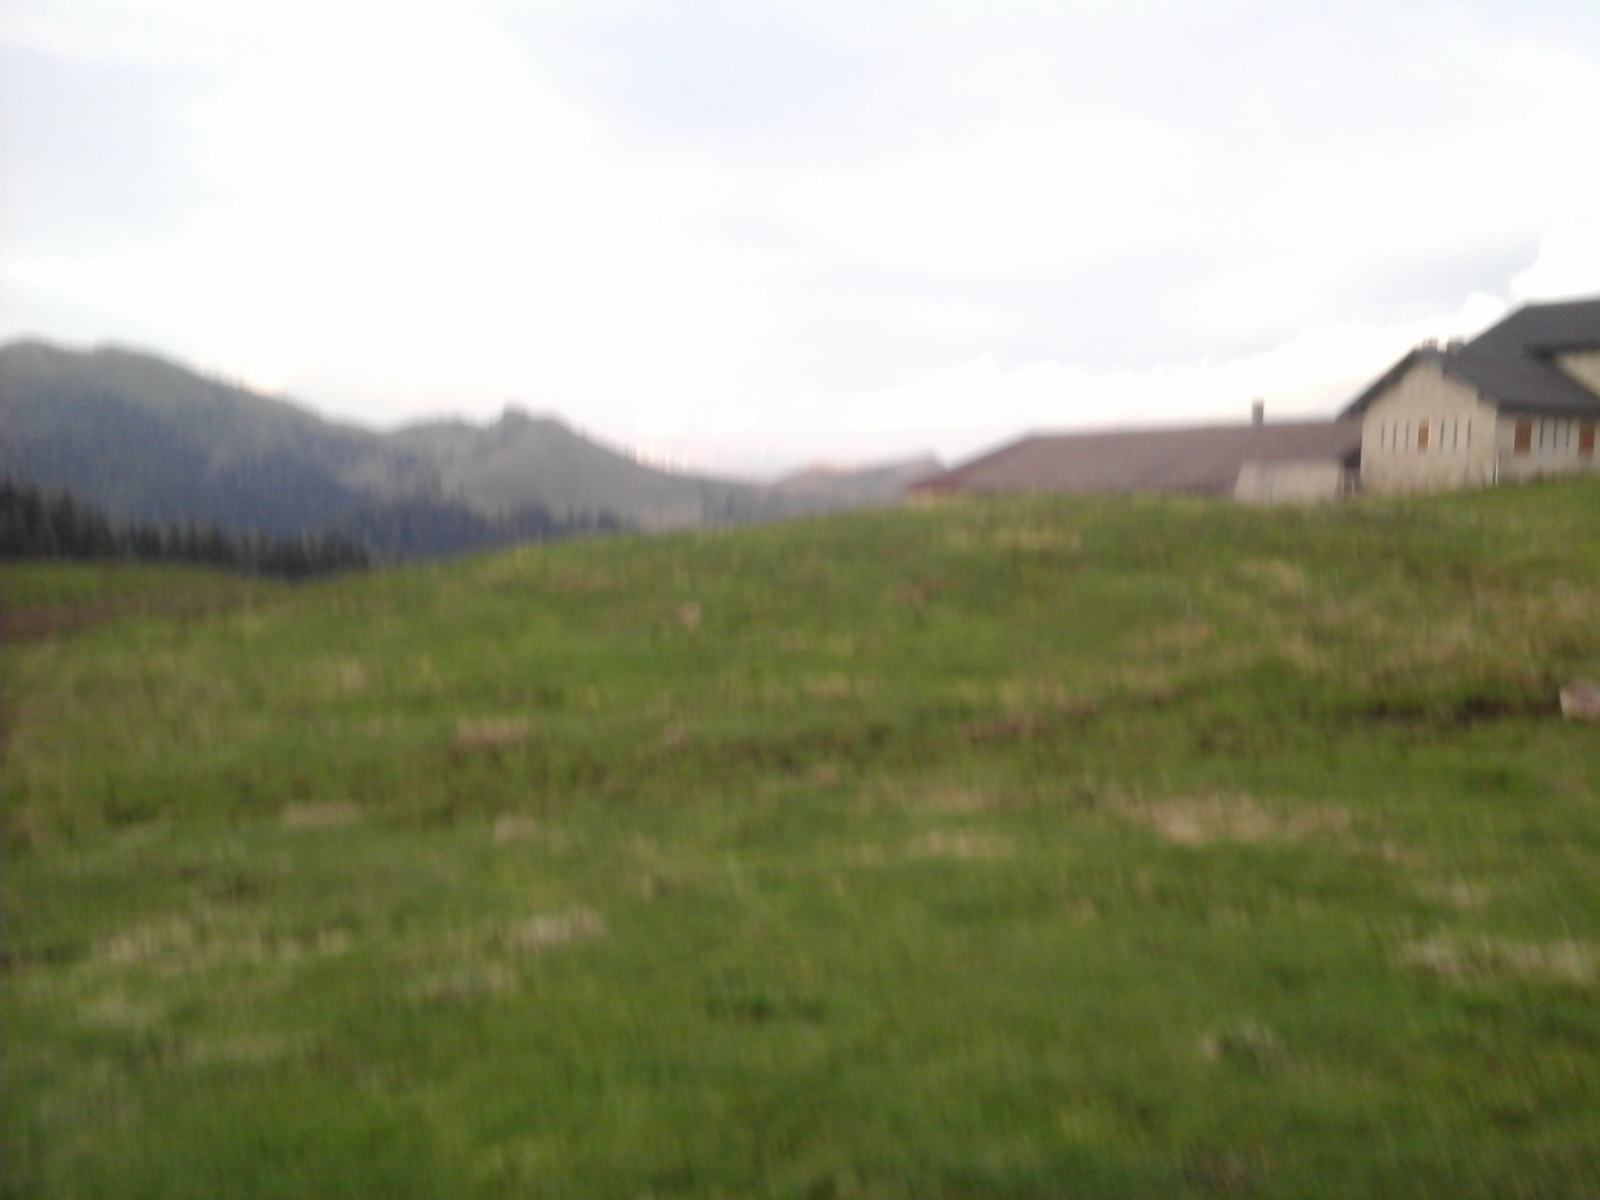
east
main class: Woodland
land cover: Pine dominated coniferous woodland
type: alpine coniferous forest
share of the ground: > 75 %
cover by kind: coniferous forest trees 100 %
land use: Forestry
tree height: > 5 m
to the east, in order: Pine dominated coniferous woodland; Shrubland with sparse tree cover; Grassland with sparse tree/shrub cover
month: May
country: IT
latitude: 45.8816
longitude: 10.5017
